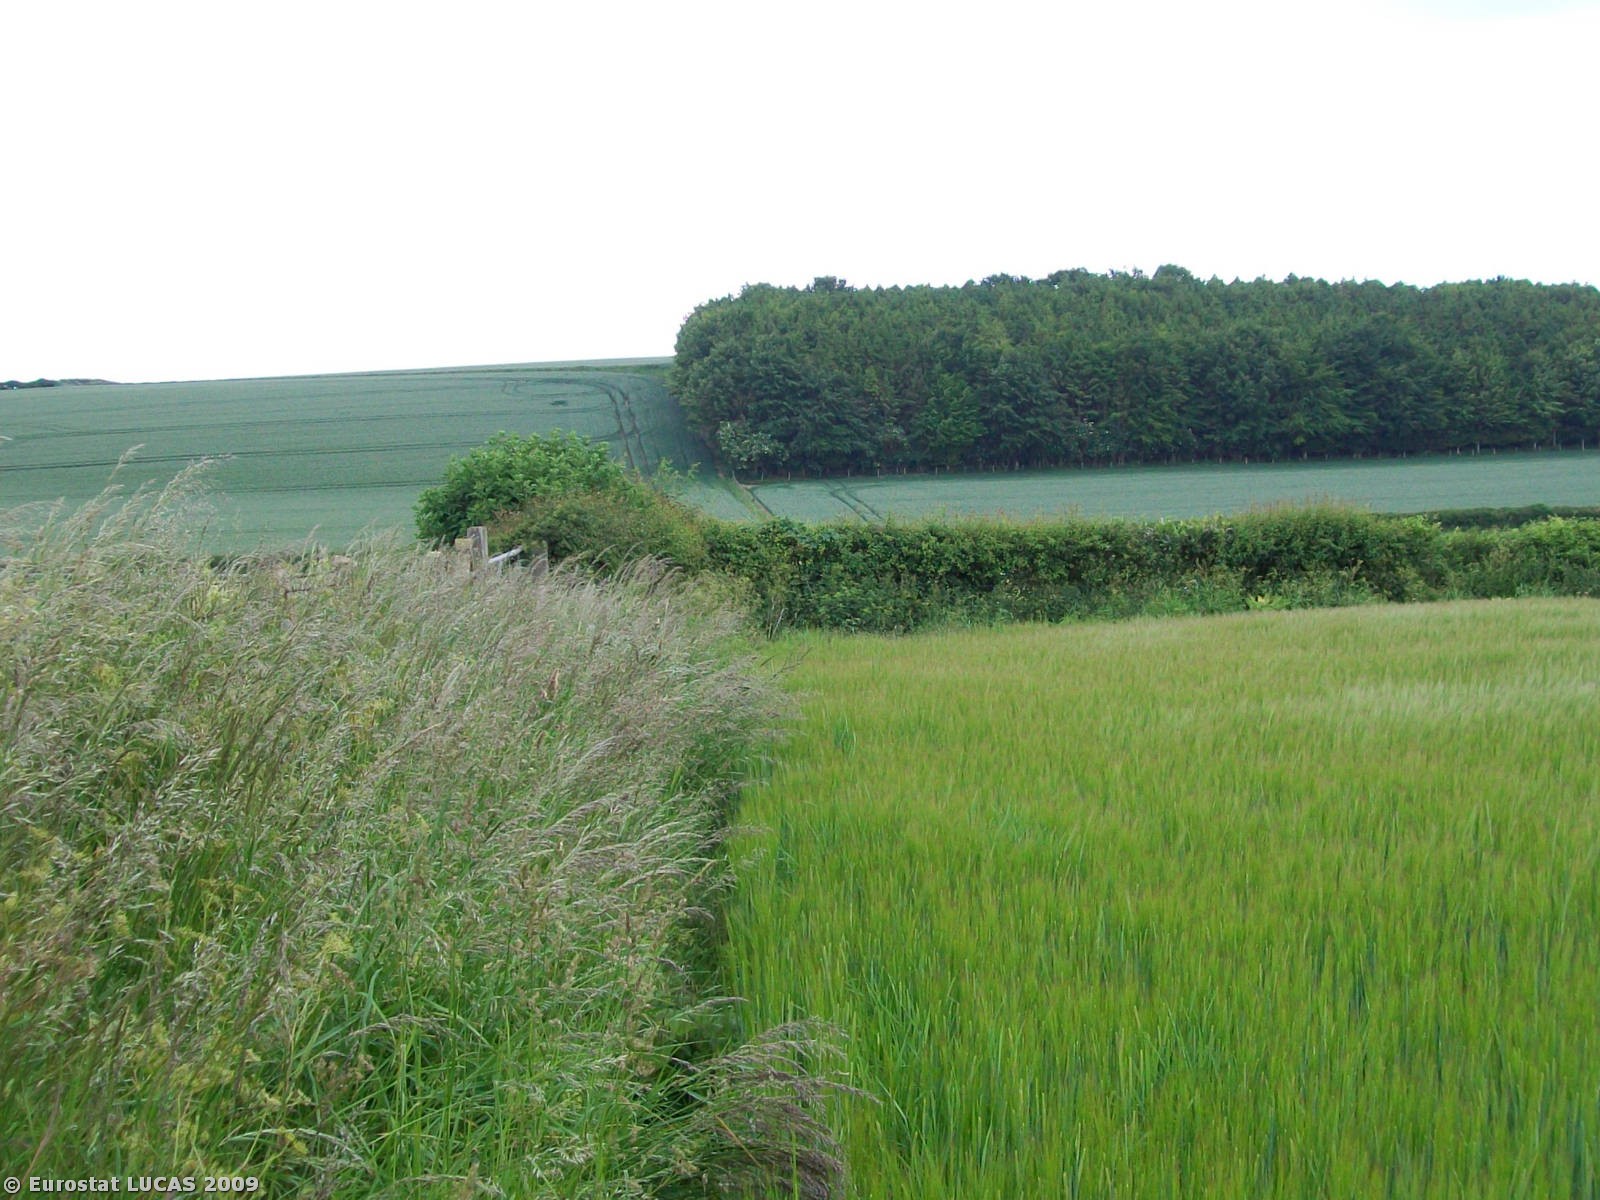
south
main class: Cropland
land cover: Barley
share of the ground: > 75 %
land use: Agriculture (excluding fallow land and kitchen gardens)
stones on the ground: 10 - 25 %
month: June
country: GB
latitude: 50.8652
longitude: -2.0943
